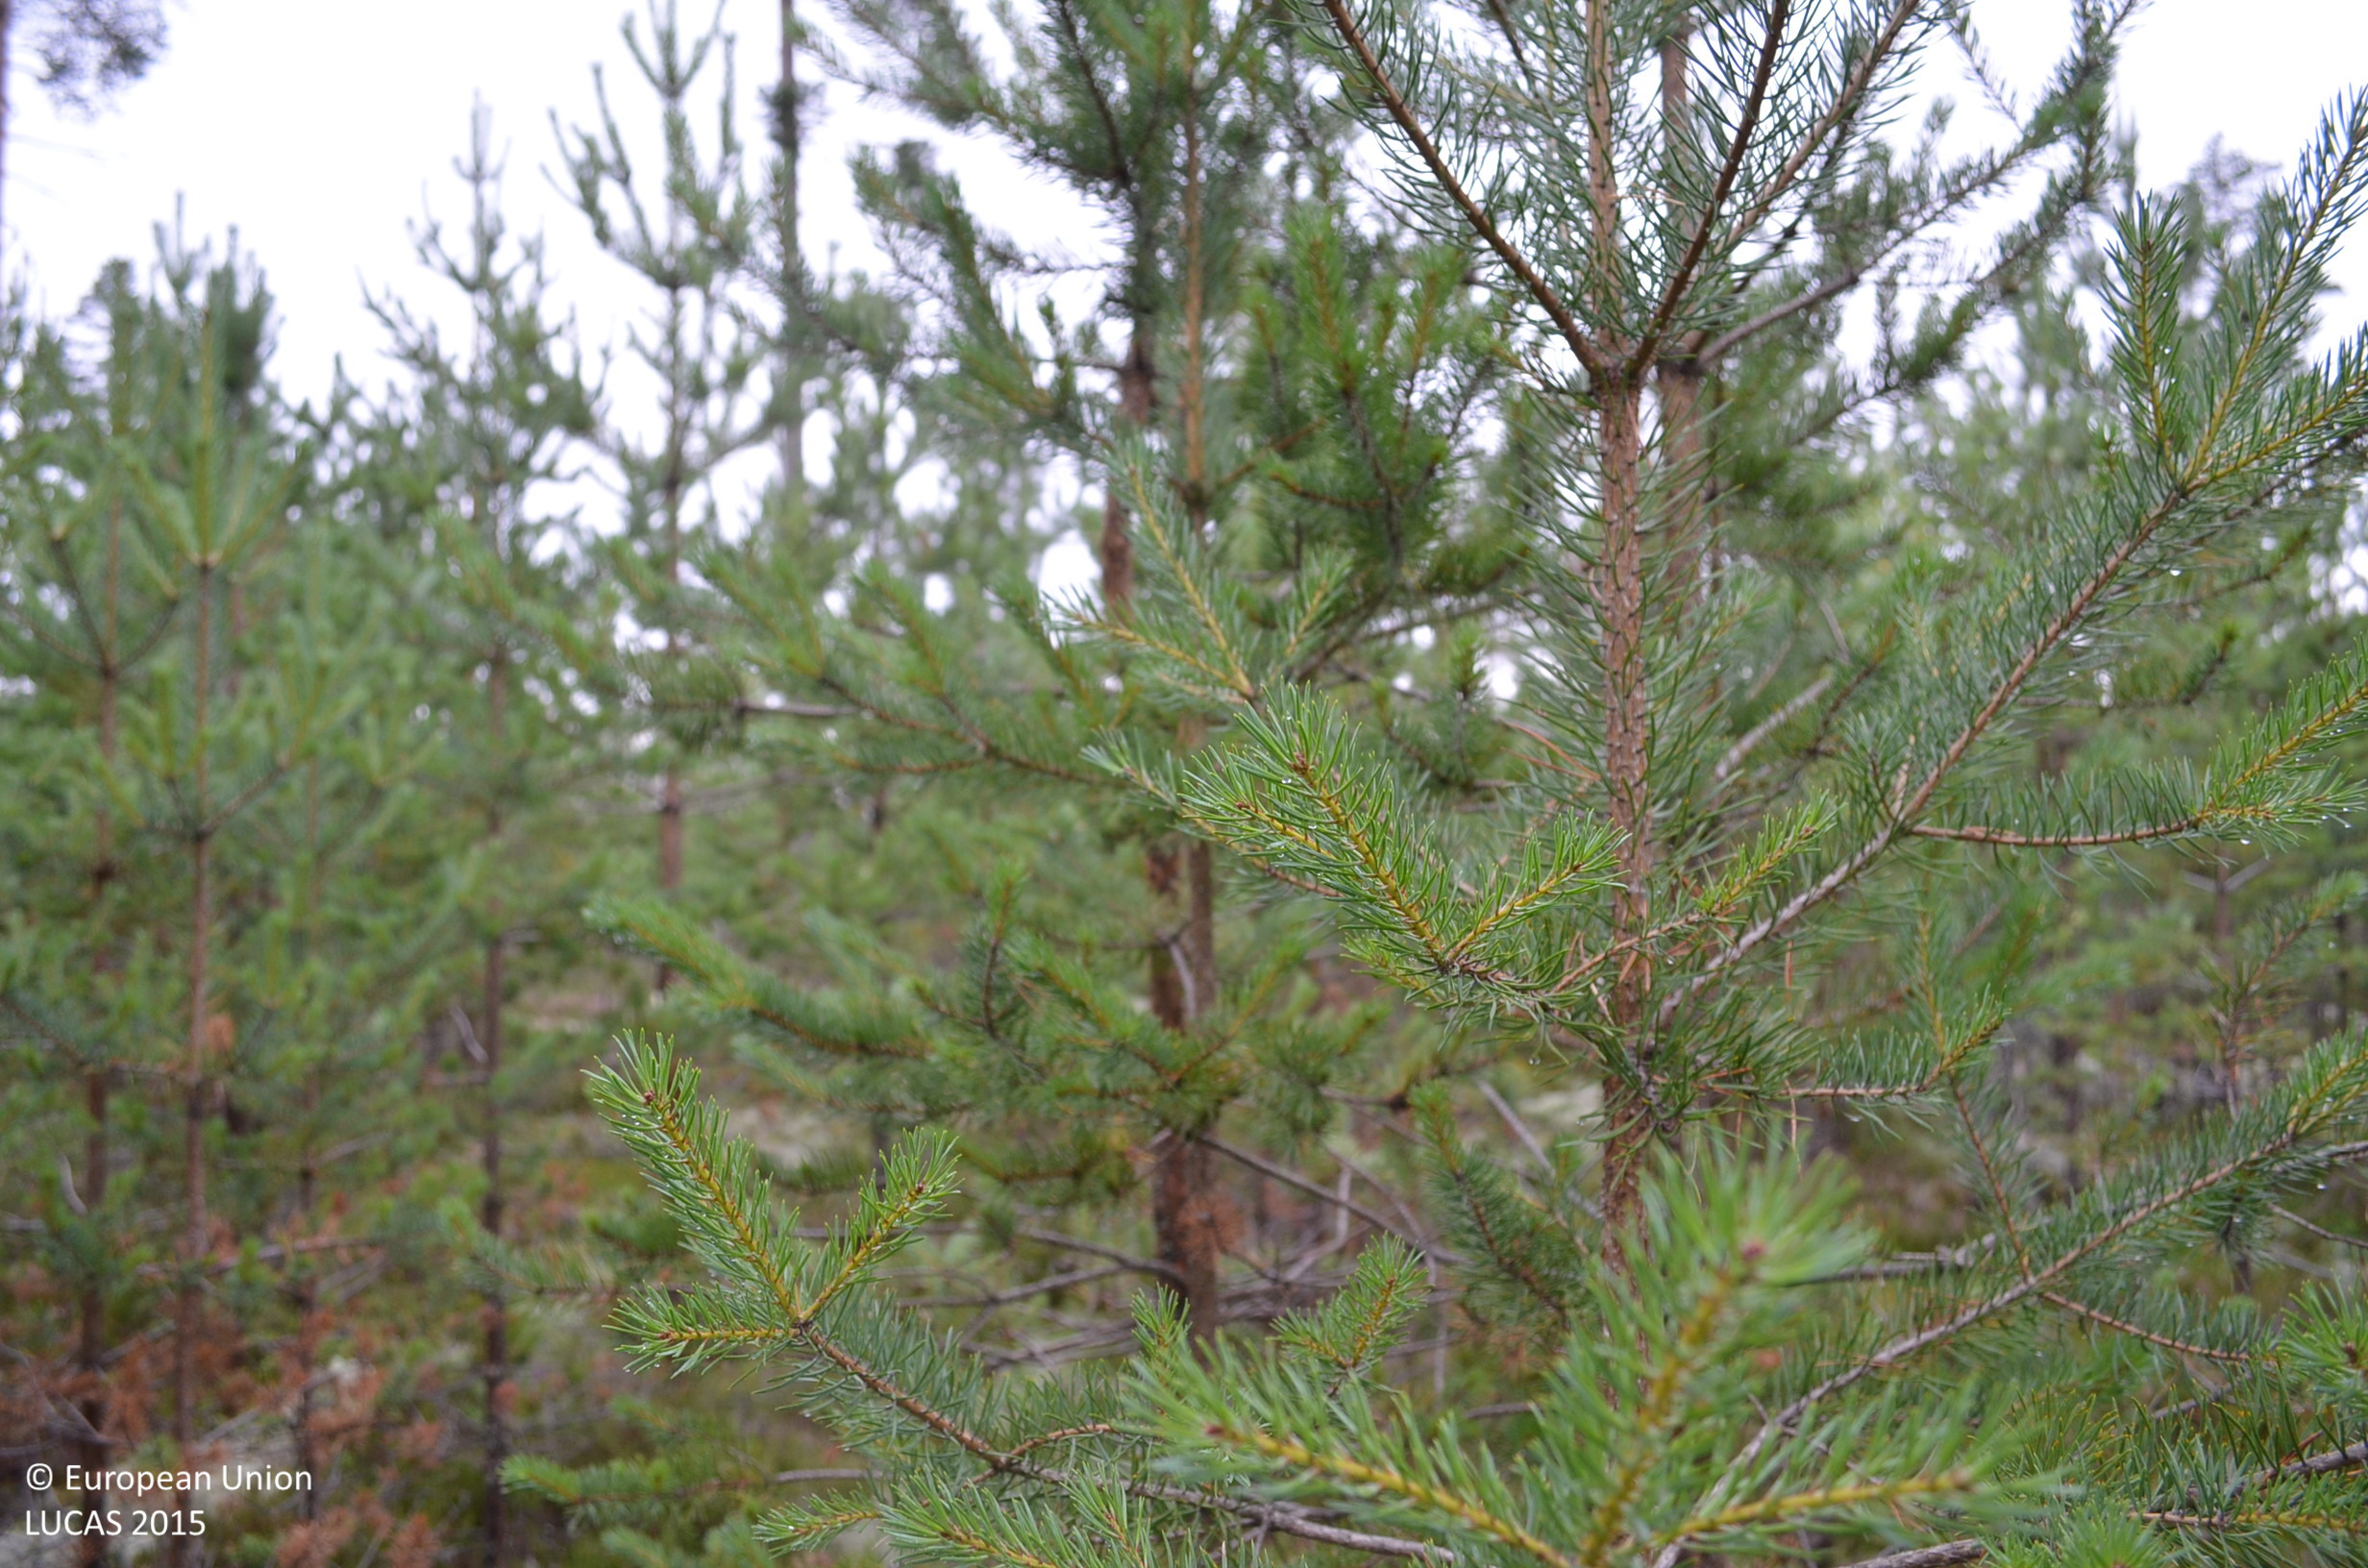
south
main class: Woodland
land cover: Pine dominated coniferous woodland
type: boreal forest
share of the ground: > 75 %
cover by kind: coniferous forest trees 75 %, shrubs 15 %, lichens and mosses 10 %
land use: Forestry
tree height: < 5 m
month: August
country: FI
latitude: 61.8320
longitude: 24.1212
